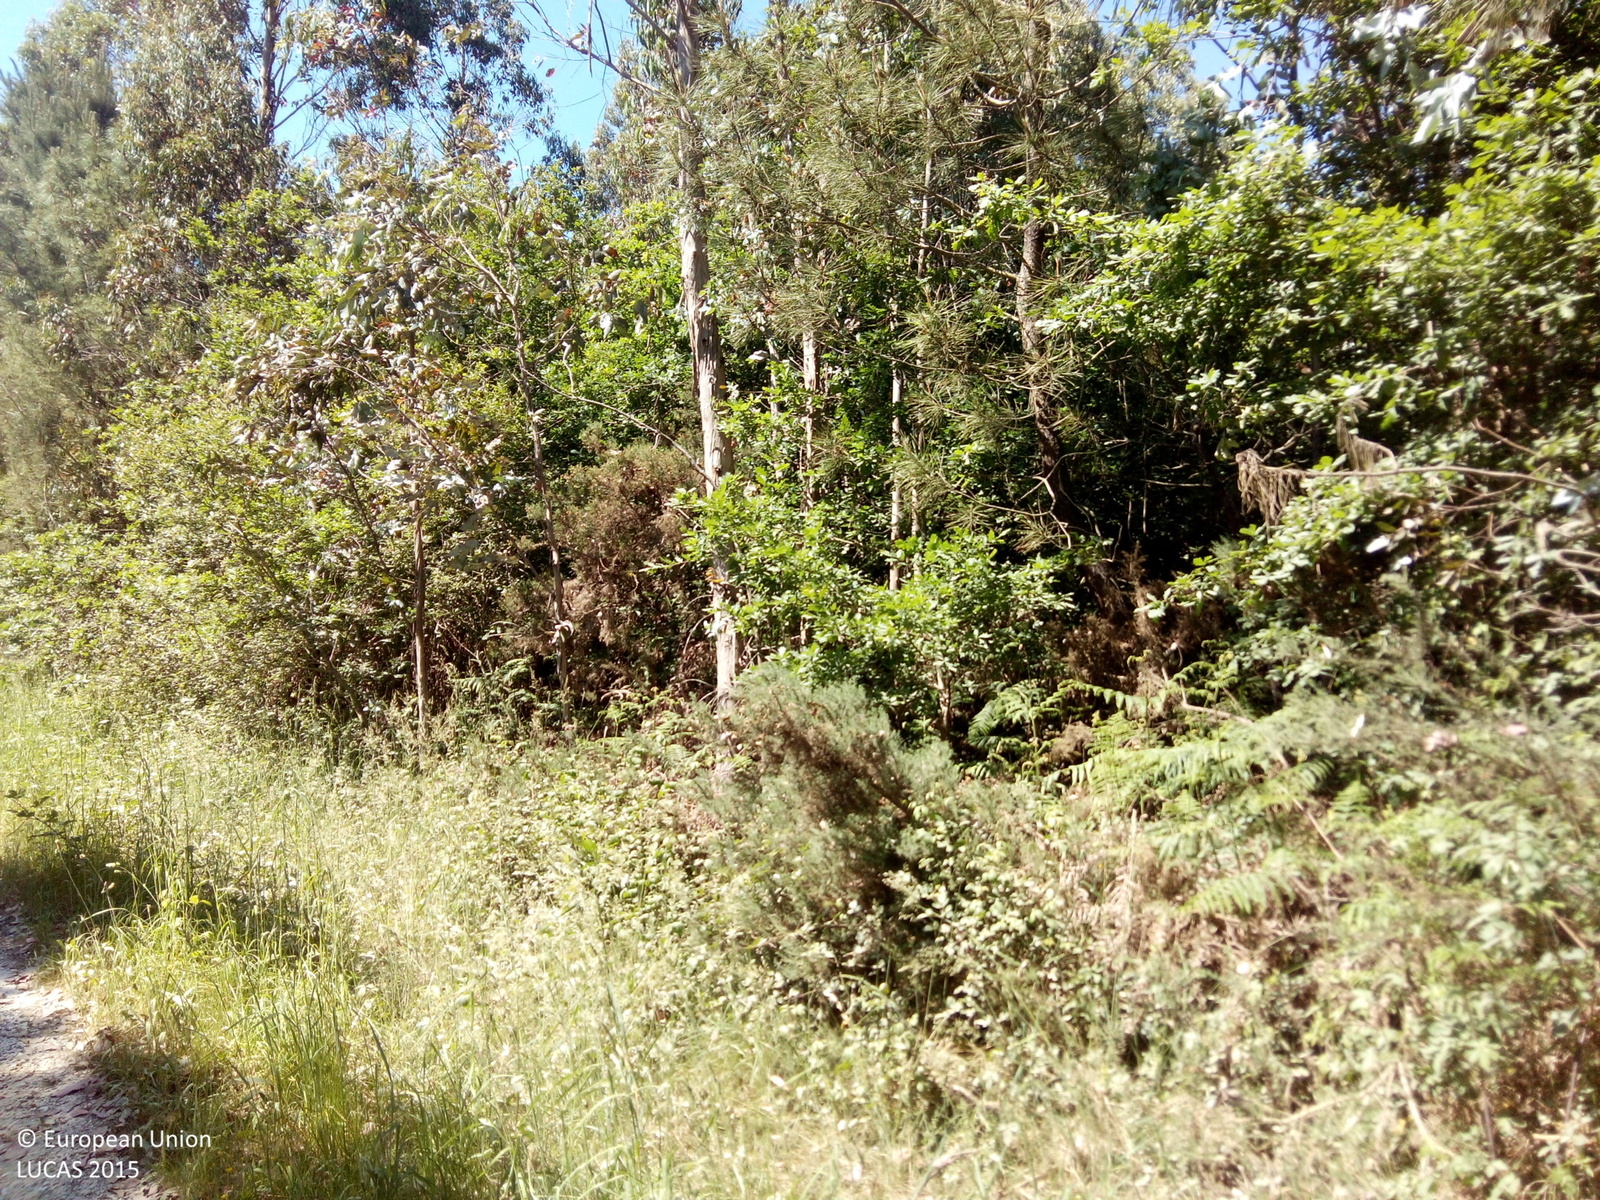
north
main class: Woodland
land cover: Pine dominated mixed woodland
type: hemiboreal forest and nemoral coniferous forest and mixed broadleaved-coniferous forest
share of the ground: > 75 %
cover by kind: coniferous forest trees 75 %, broadleaved forest trees 25 %
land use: Forestry
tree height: > 5 m
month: May
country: ES
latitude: 42.7935
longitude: -8.4265
